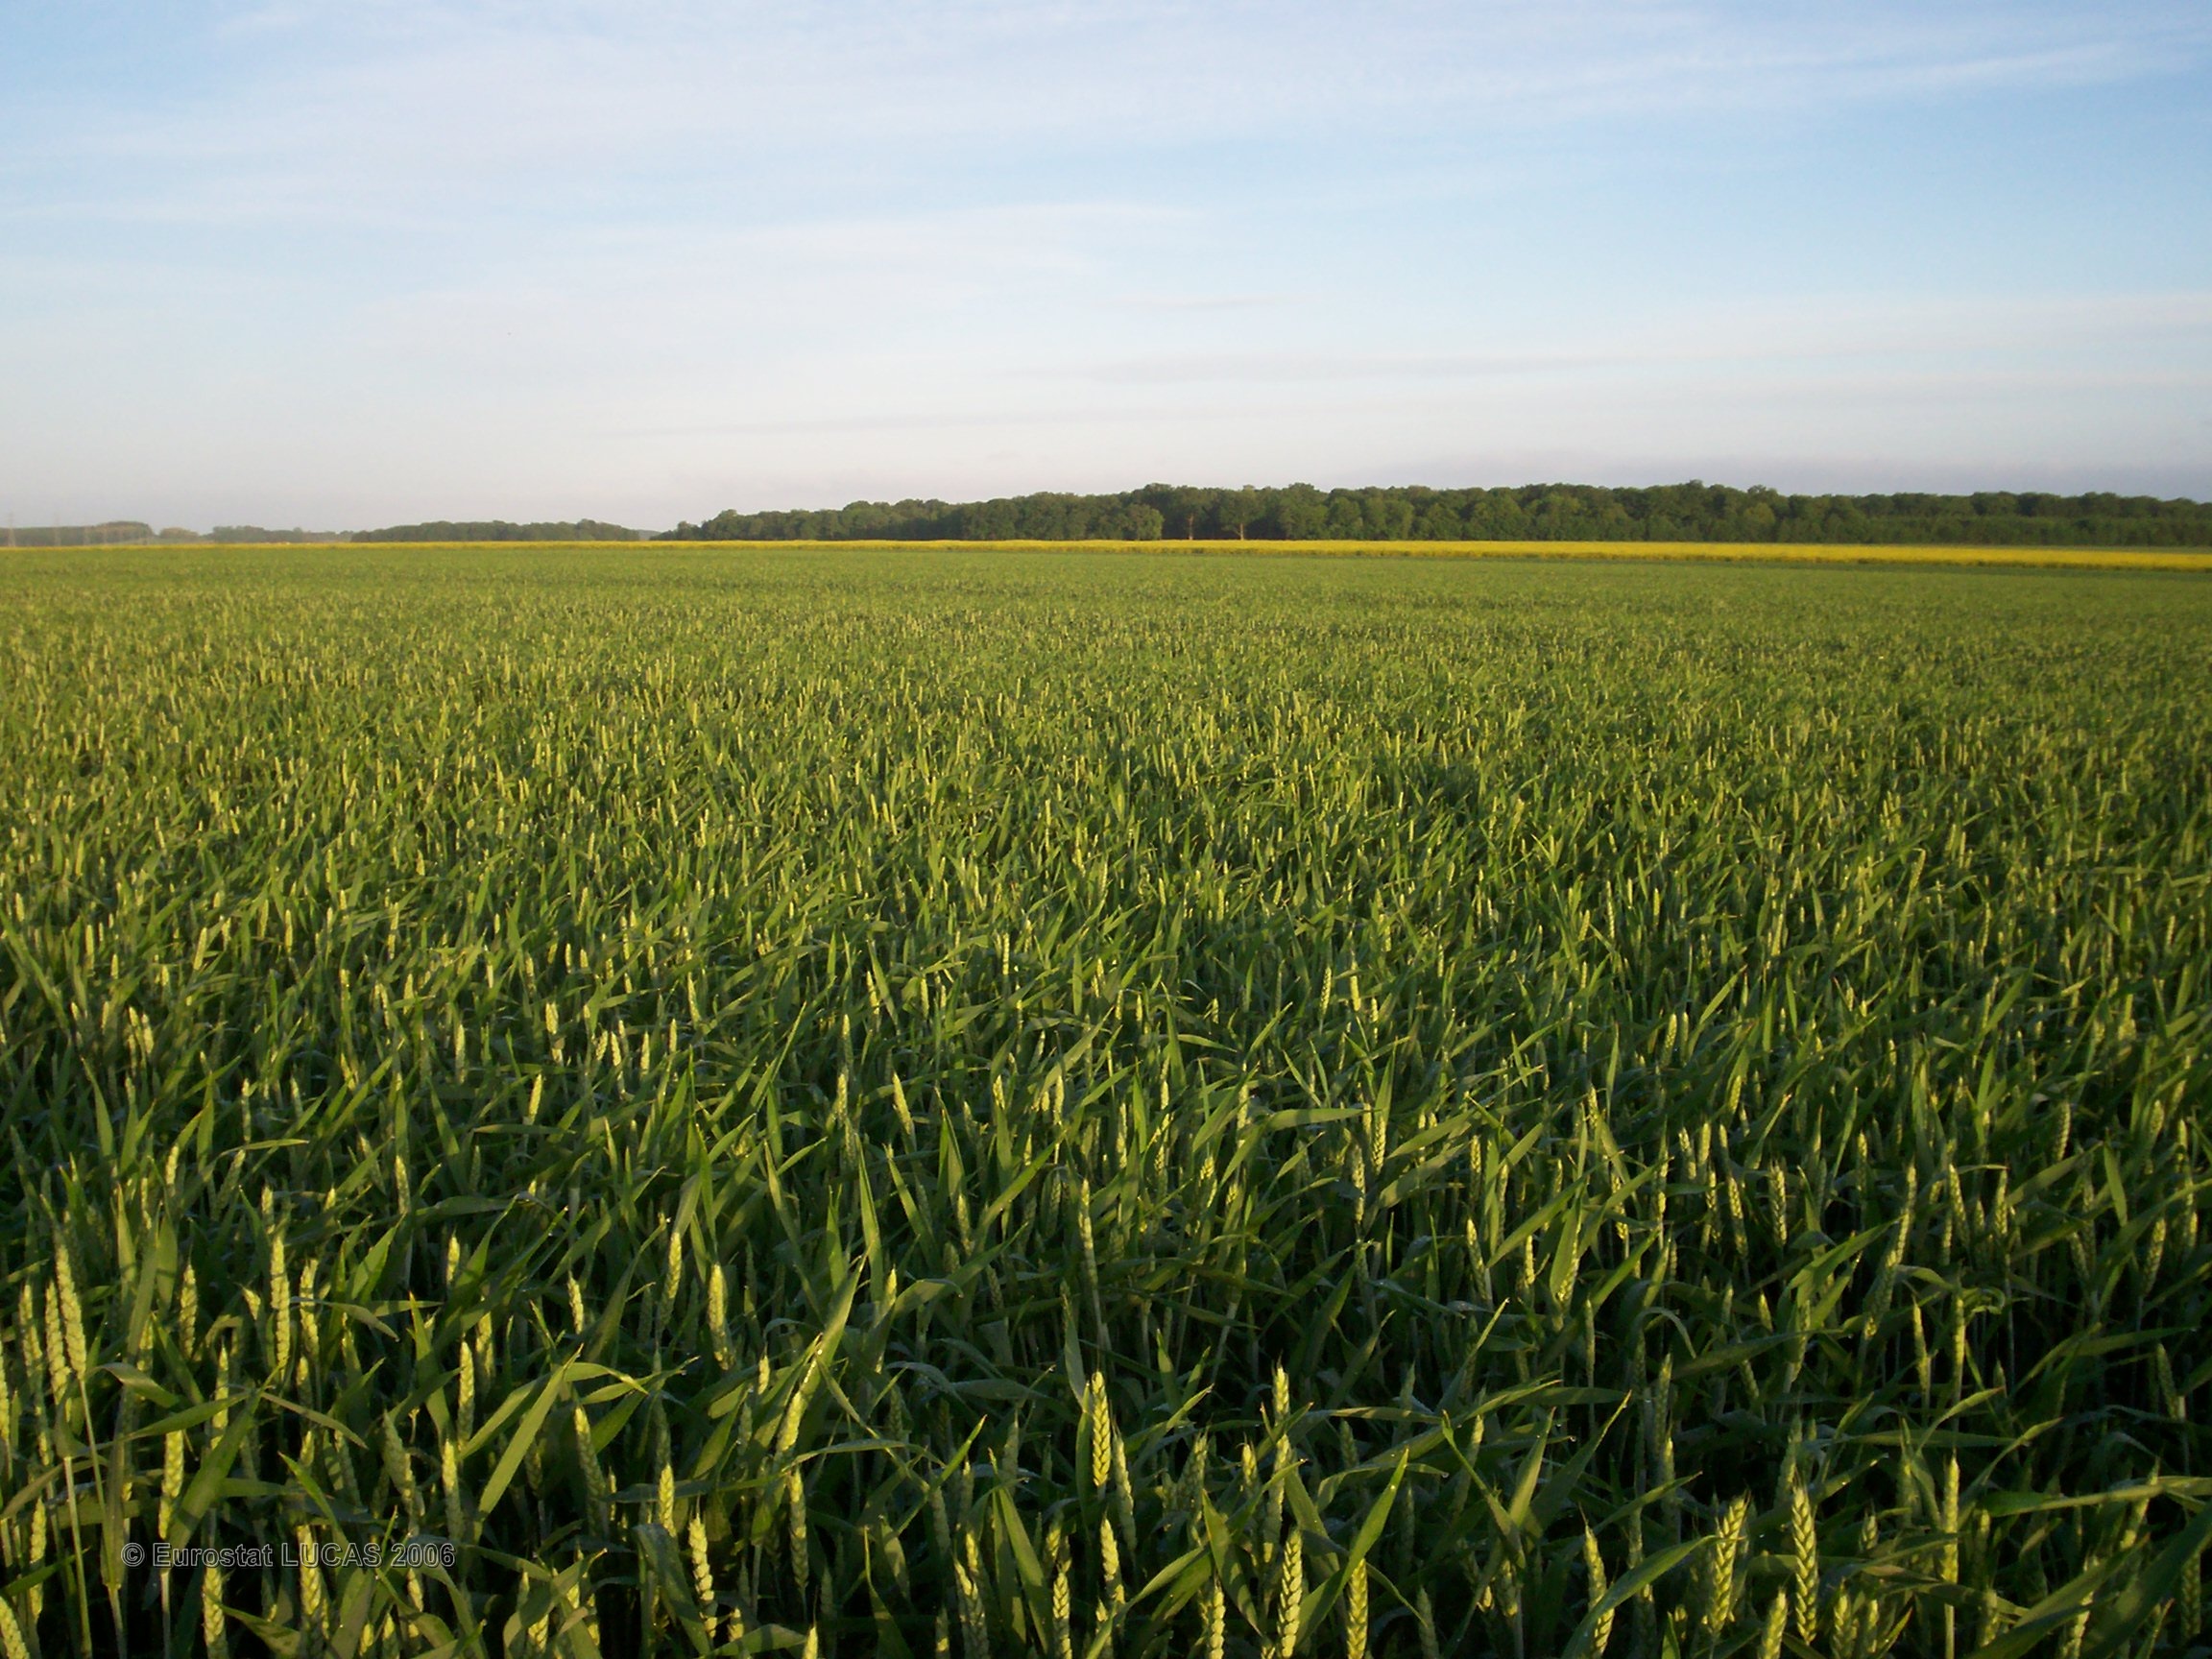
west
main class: Cropland
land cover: Common wheat
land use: Agriculture (excluding fallow land and kitchen gardens)
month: May
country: FR
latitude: 47.3314
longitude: 5.3296
